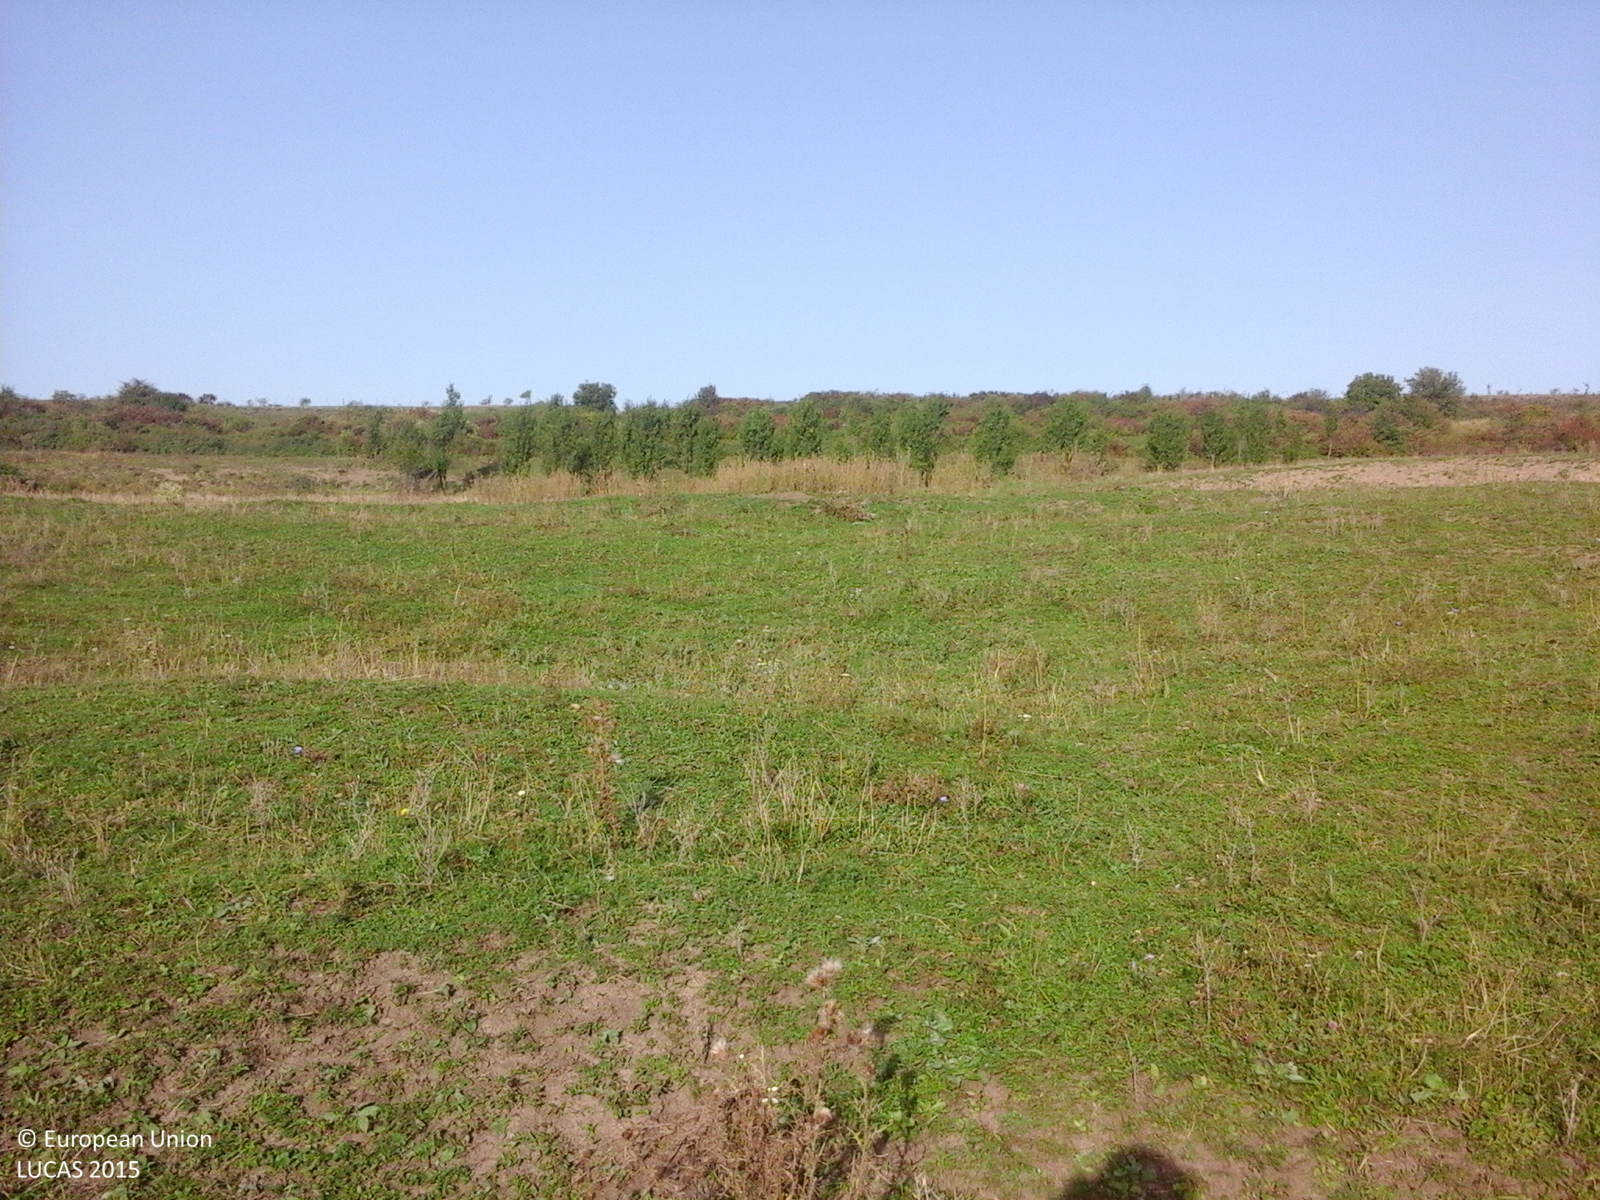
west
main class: Grassland
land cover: Grassland without tree/shrub cover
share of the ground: > 75 %
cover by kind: herbaceous plants 100 %
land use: Agriculture (excluding fallow land and kitchen gardens)
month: September
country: RO
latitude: 47.0320
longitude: 23.7209
